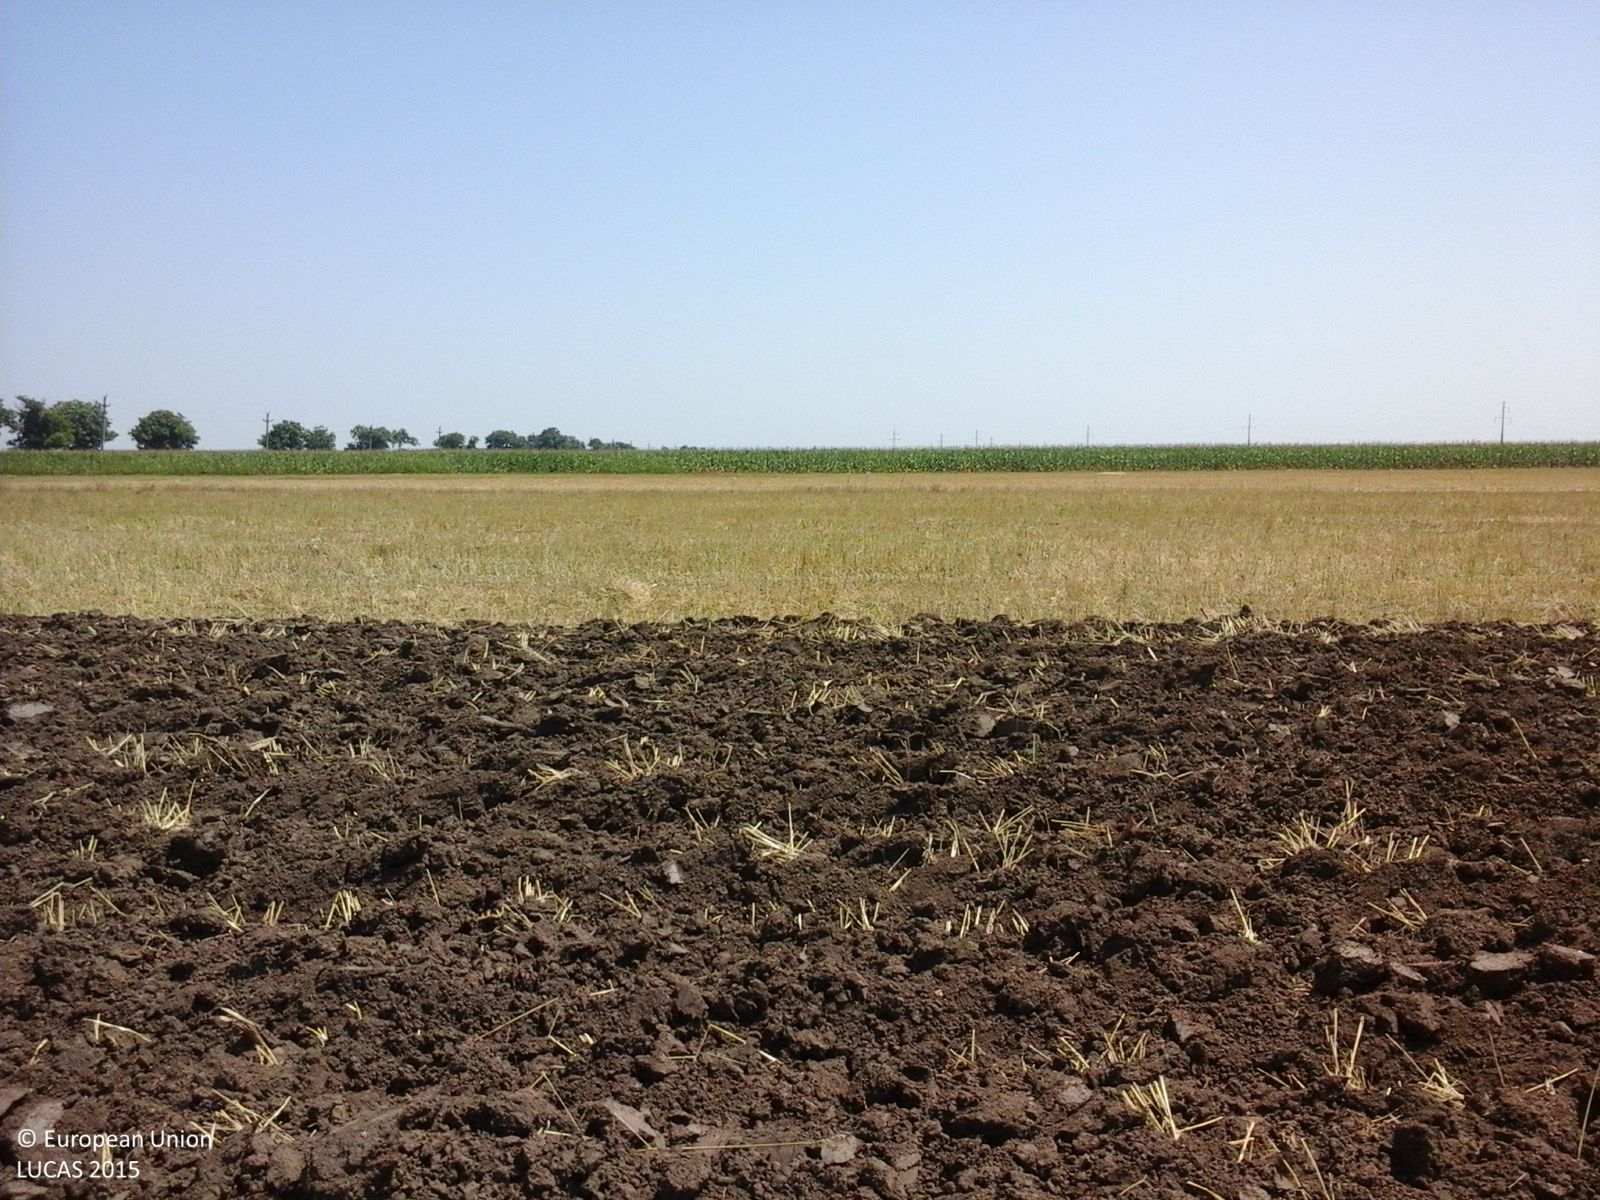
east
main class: Cropland
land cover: Common wheat
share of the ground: < 10 %
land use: Agriculture (excluding fallow land and kitchen gardens)
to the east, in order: Common wheat; Grass margins; Tracks; Common wheat; Maize
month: July
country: RO
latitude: 44.5015
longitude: 26.7623
